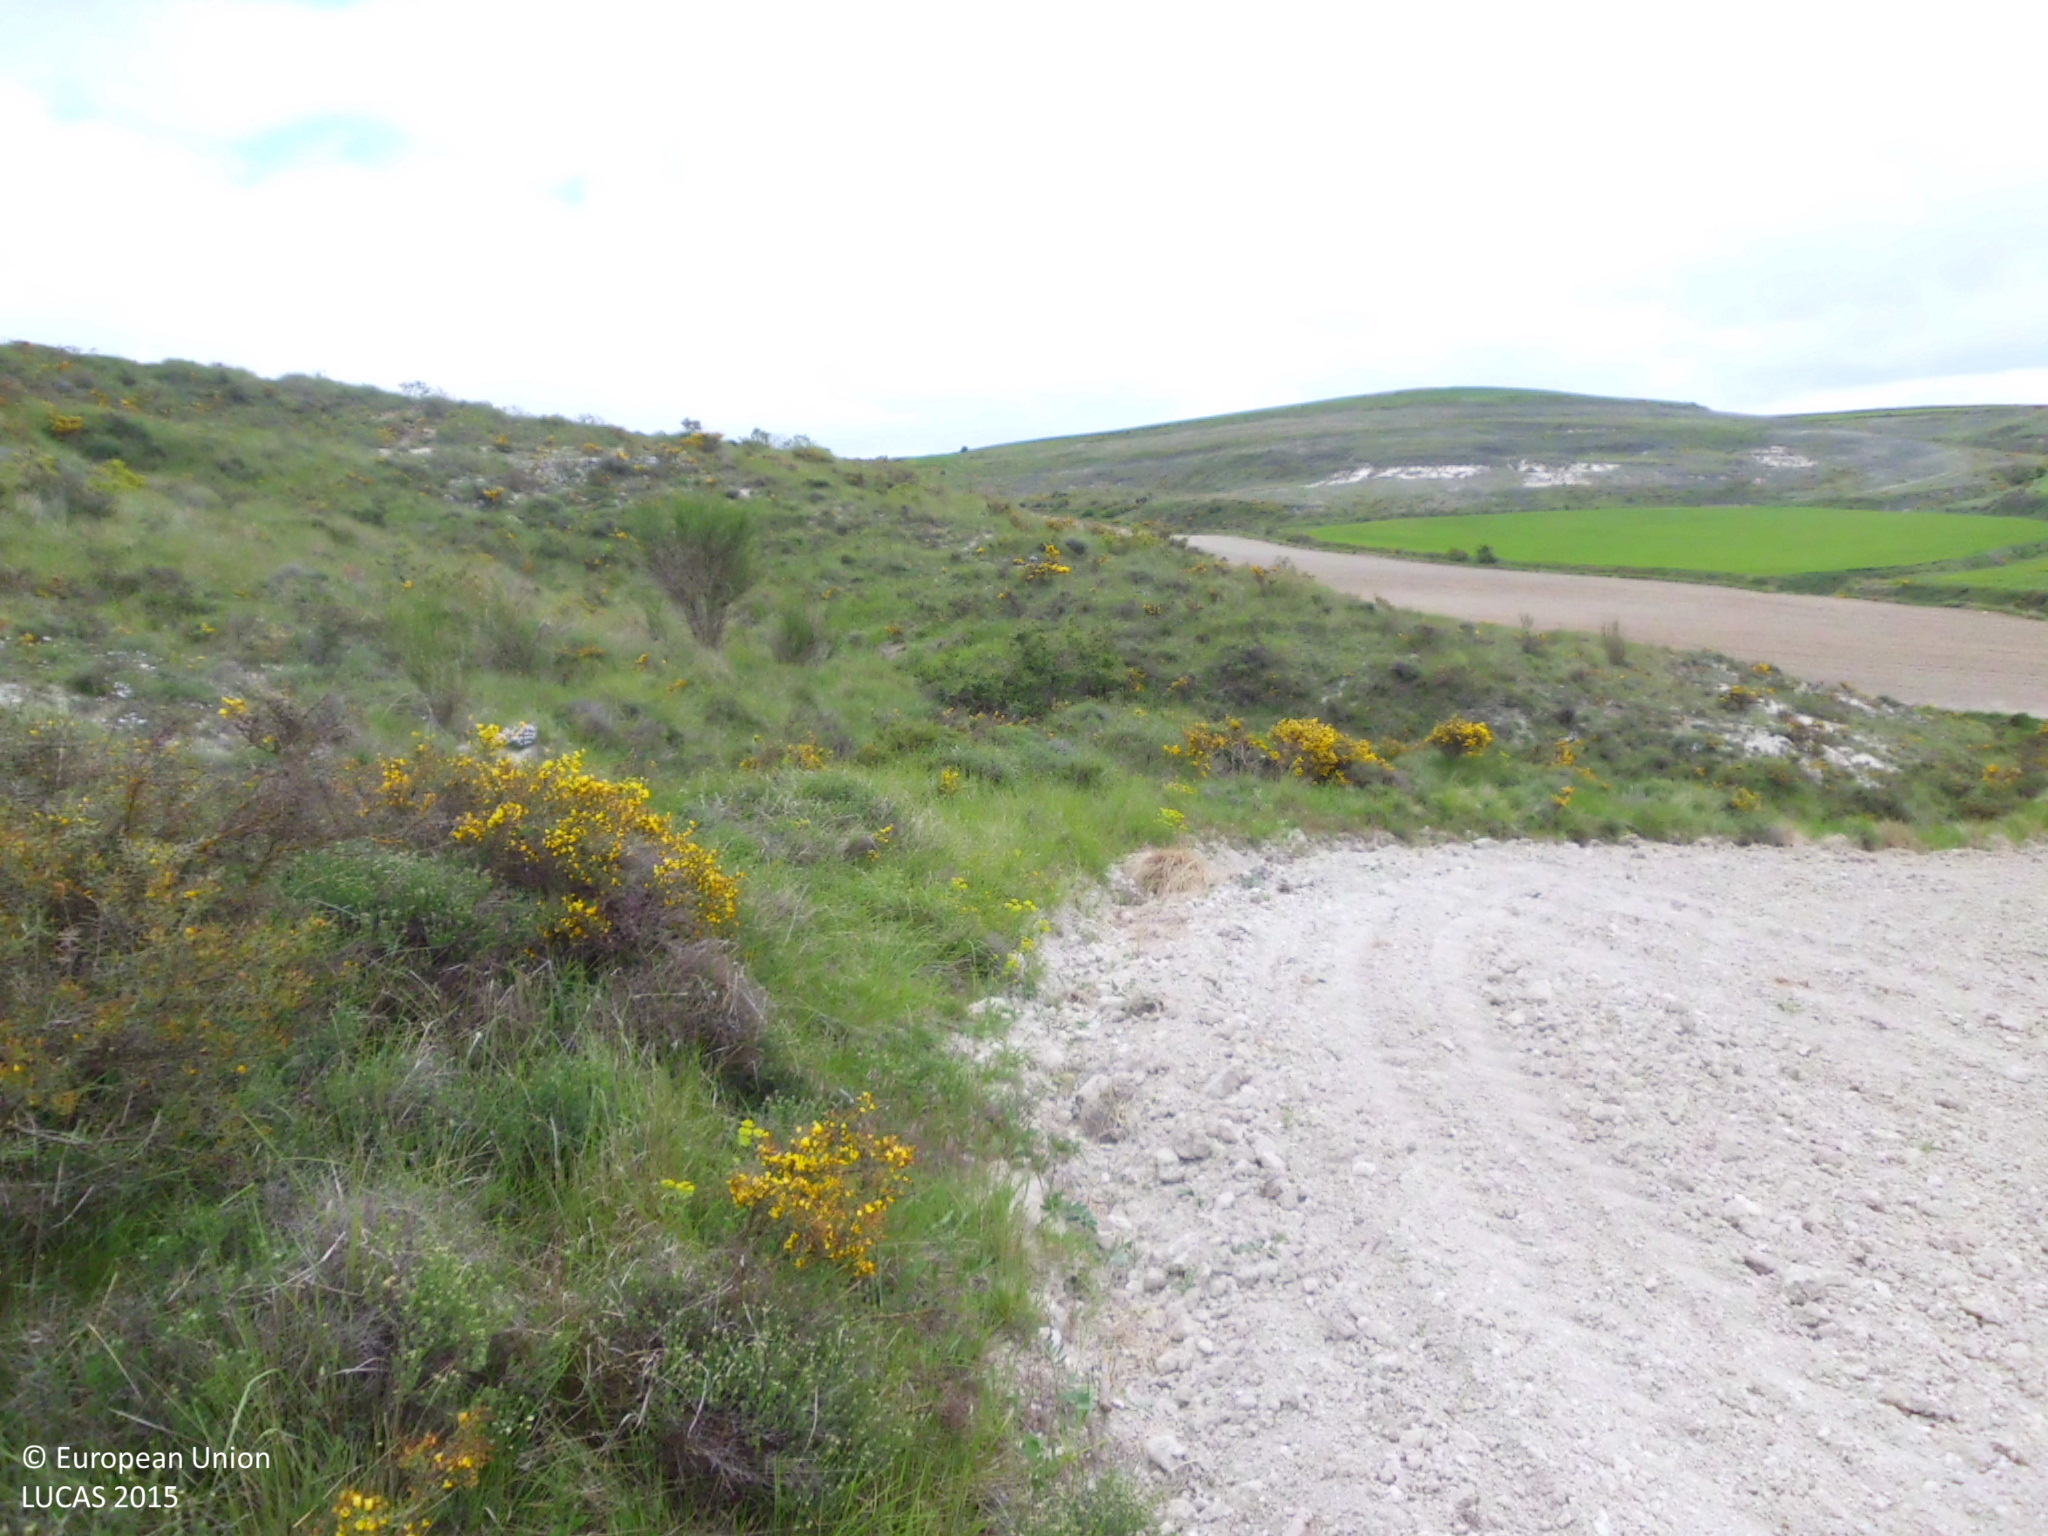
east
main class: Shrubland
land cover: Shrubland without tree cover
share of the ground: > 75 %
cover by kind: shrubs 60 %, herbaceous plants 40 %
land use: Semi-natural and natural areas not in use
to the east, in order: Shrubland without tree cover; Sunflower
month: May
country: ES
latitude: 42.5242
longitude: -3.9562
